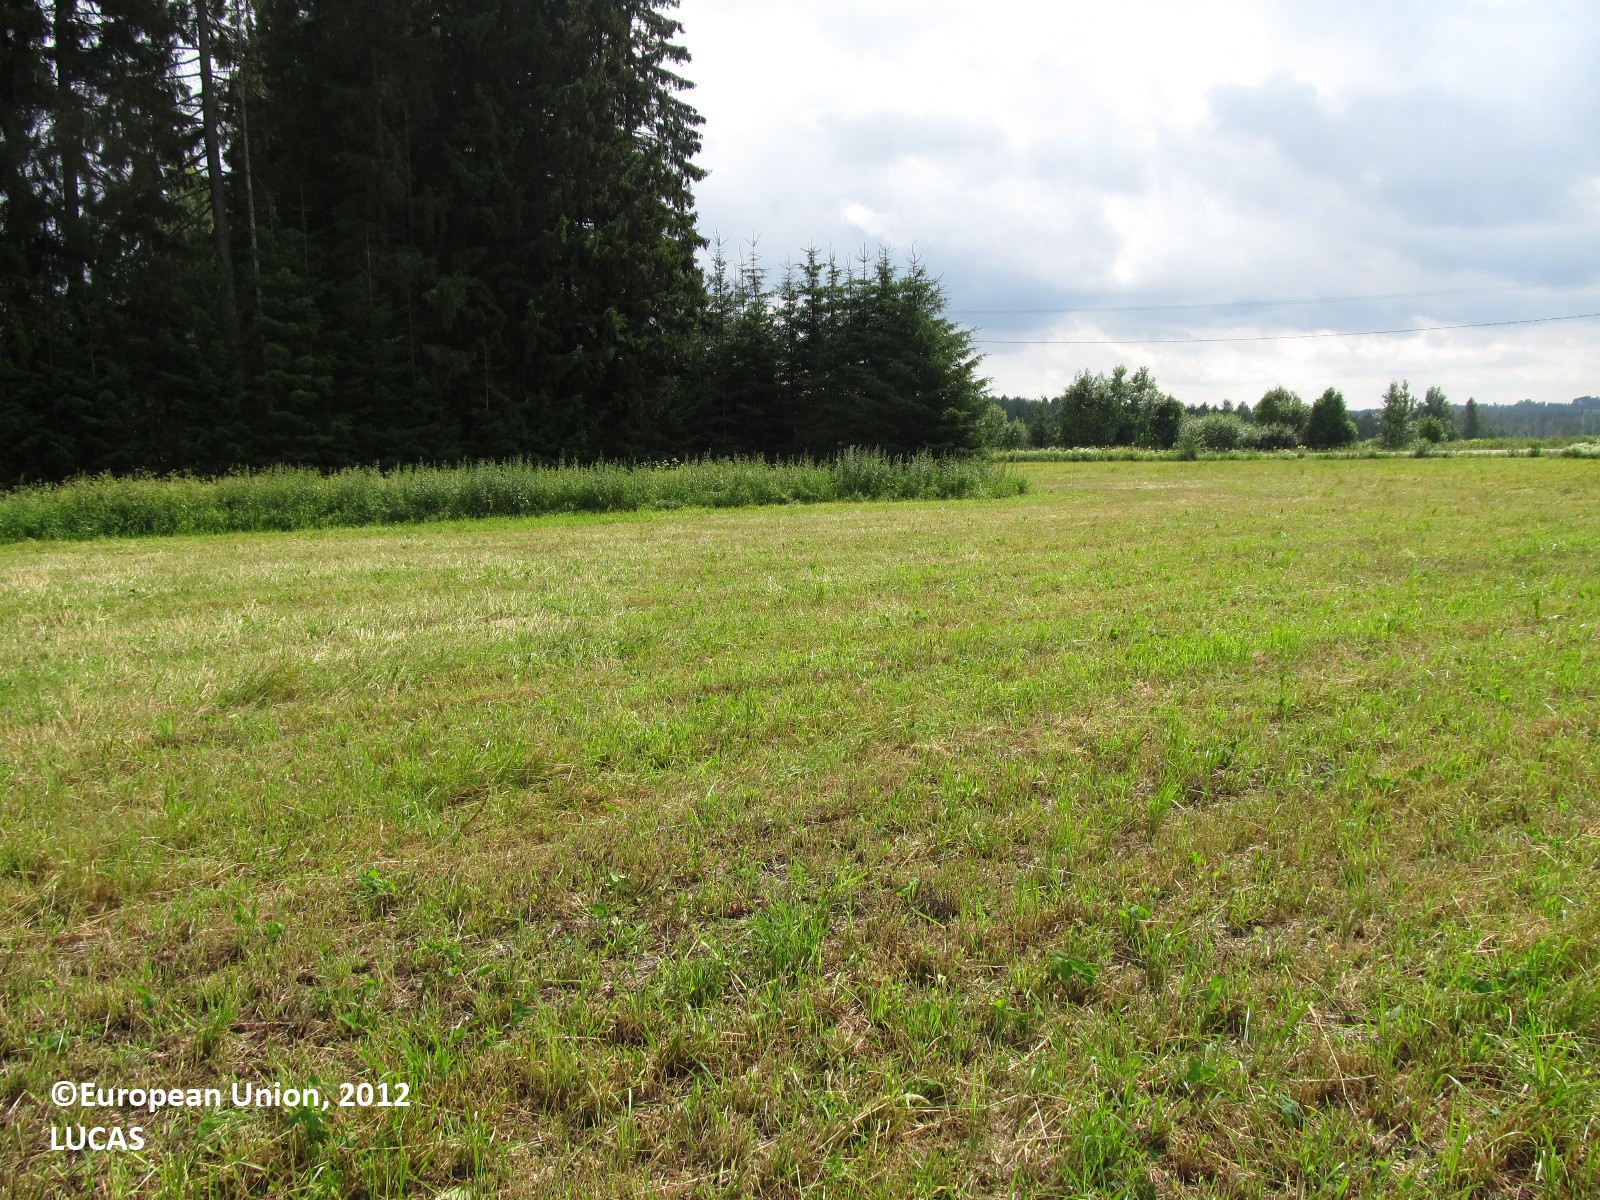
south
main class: Grassland
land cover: Grassland without tree/shrub cover
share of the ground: 50 - 75 %
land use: Fallow land
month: July
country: FI
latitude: 61.9196
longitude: 28.3113
